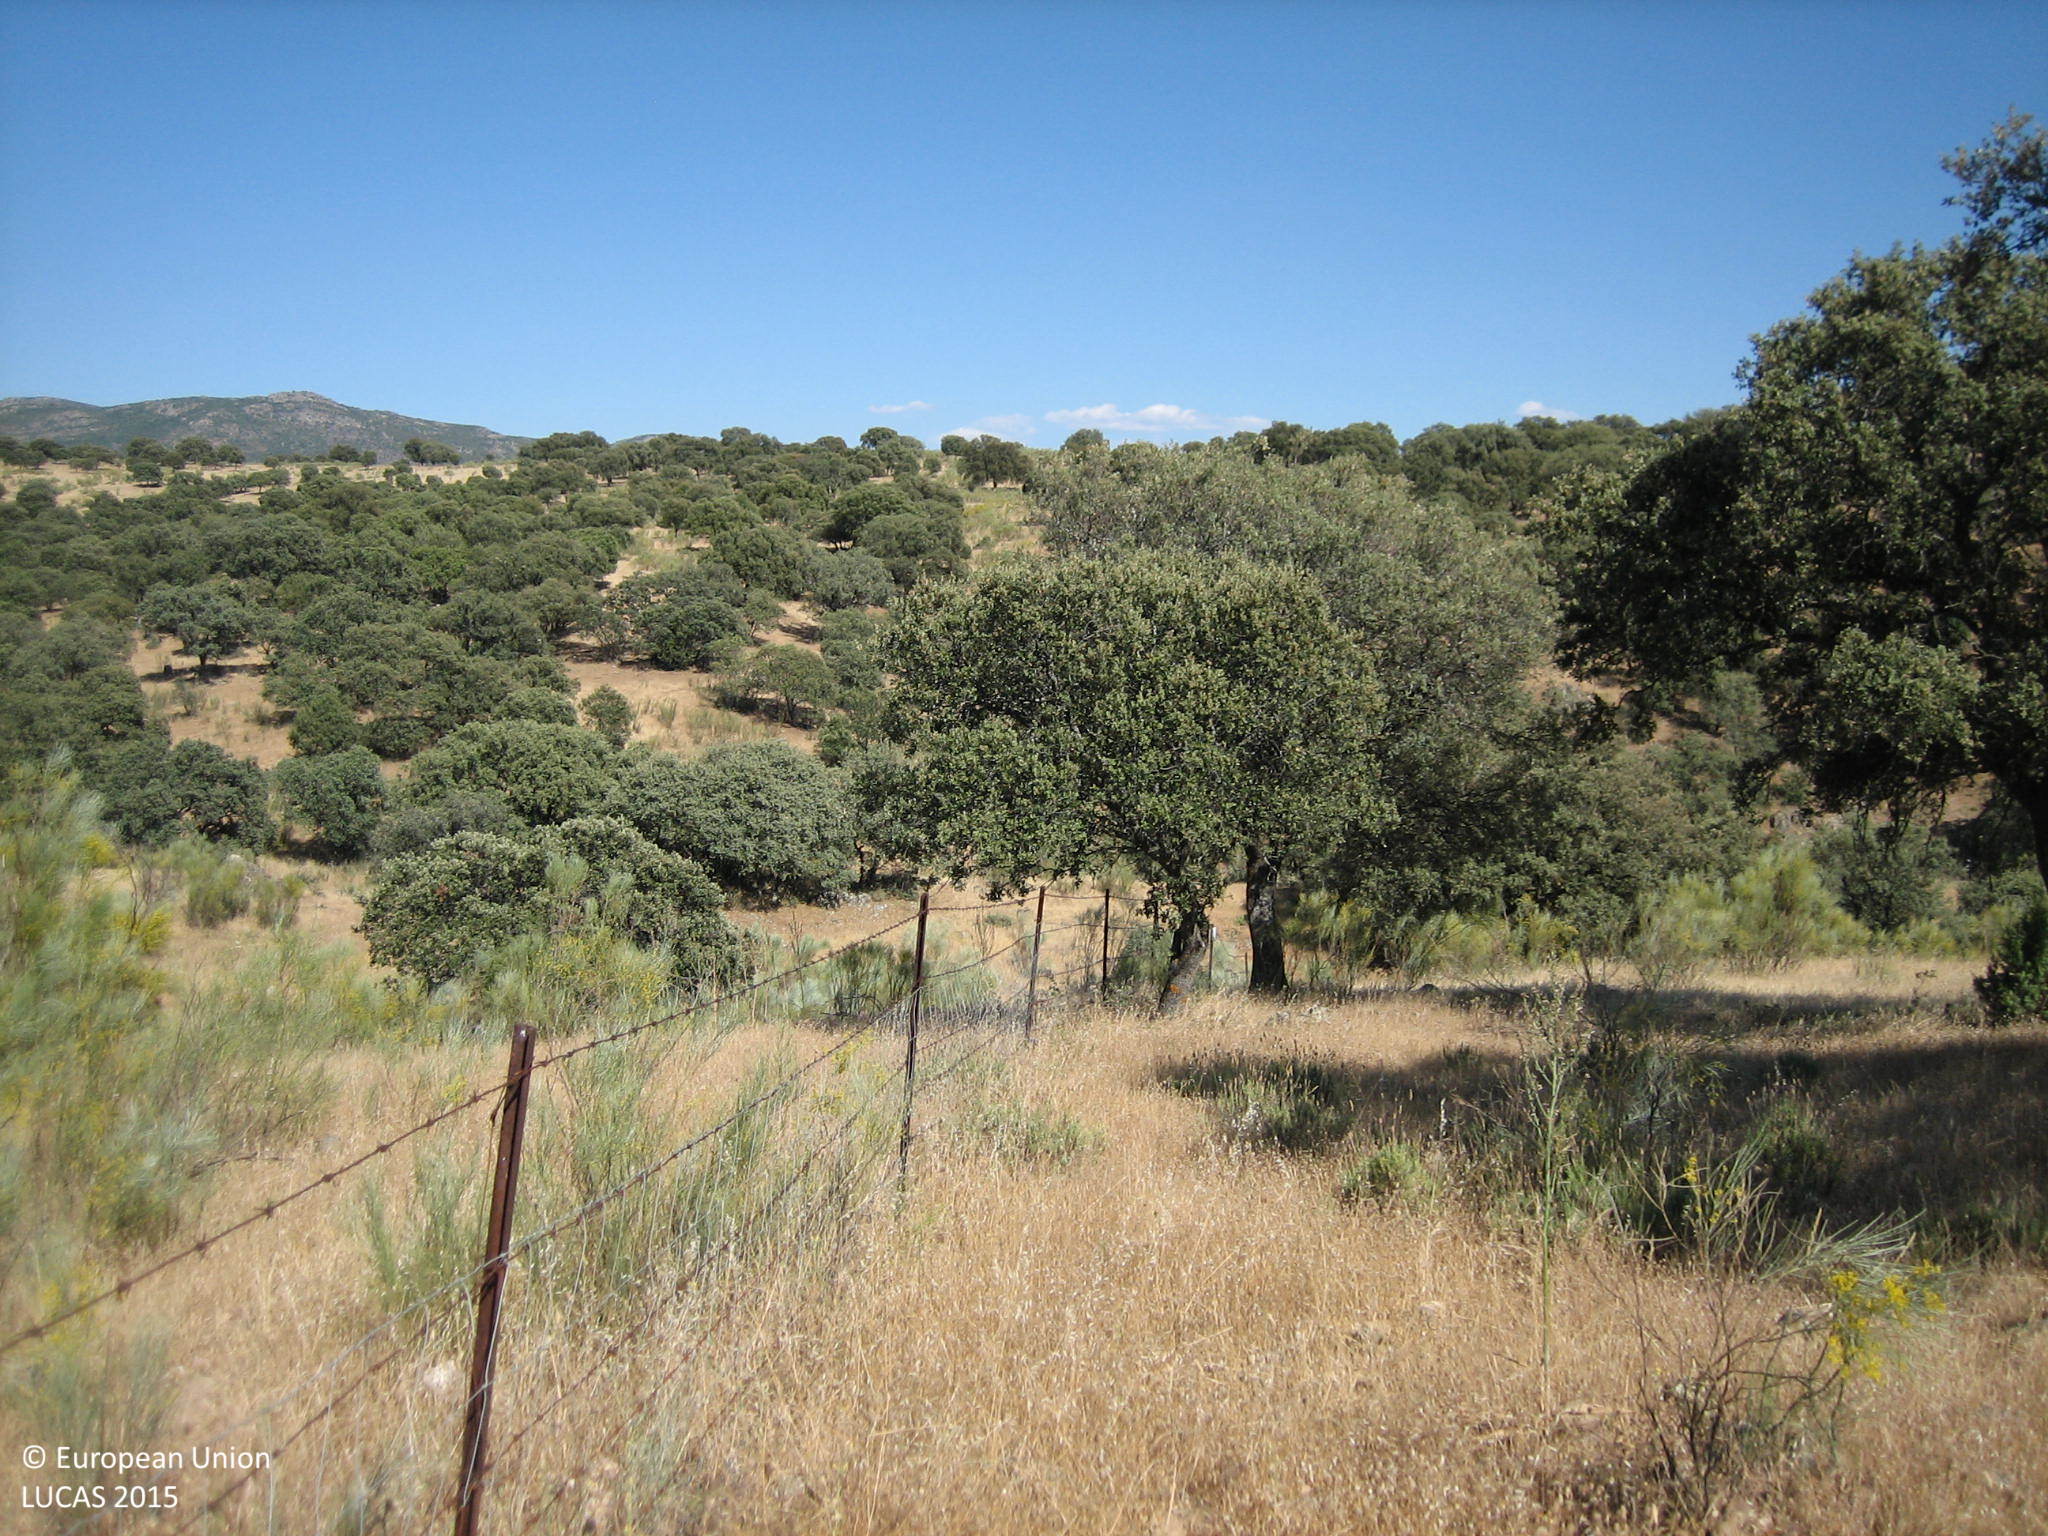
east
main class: Grassland
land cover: Grassland with sparse tree/shrub cover
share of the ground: > 75 %
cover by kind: herbaceous plants 90 %, broadleaved forest trees 5 %, shrubs 5 %
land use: Agriculture (excluding fallow land and kitchen gardens)
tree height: > 5 m
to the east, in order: Grassland with sparse tree/shrub cover; Grassland without tree/shrub cover; Grassland with sparse tree/shrub cover
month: May
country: ES
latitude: 38.5459
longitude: -3.9780
